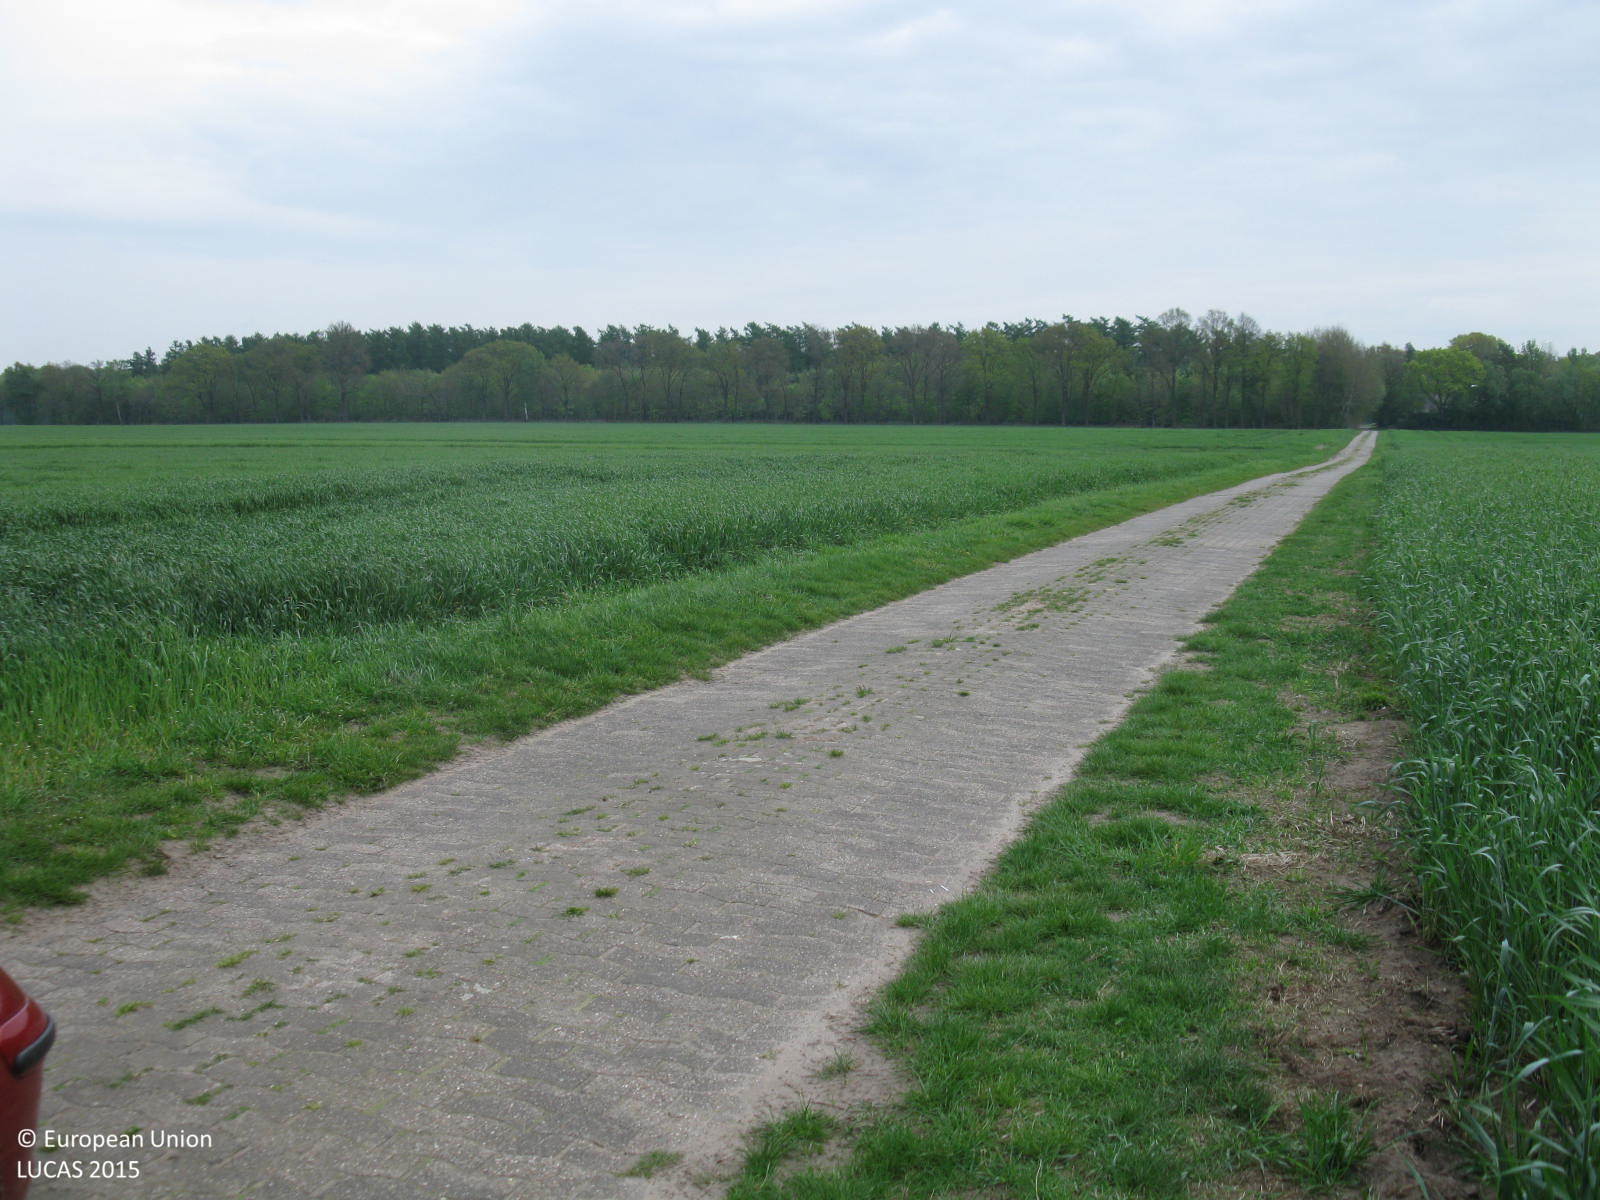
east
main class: Cropland
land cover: Rye
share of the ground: > 75 %
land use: Agriculture (excluding fallow land and kitchen gardens)
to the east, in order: Rye; Grass margins; Paved roads, cycling and walking lanes; Grass margins; Barley
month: May
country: DE
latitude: 52.8450
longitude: 7.9368
